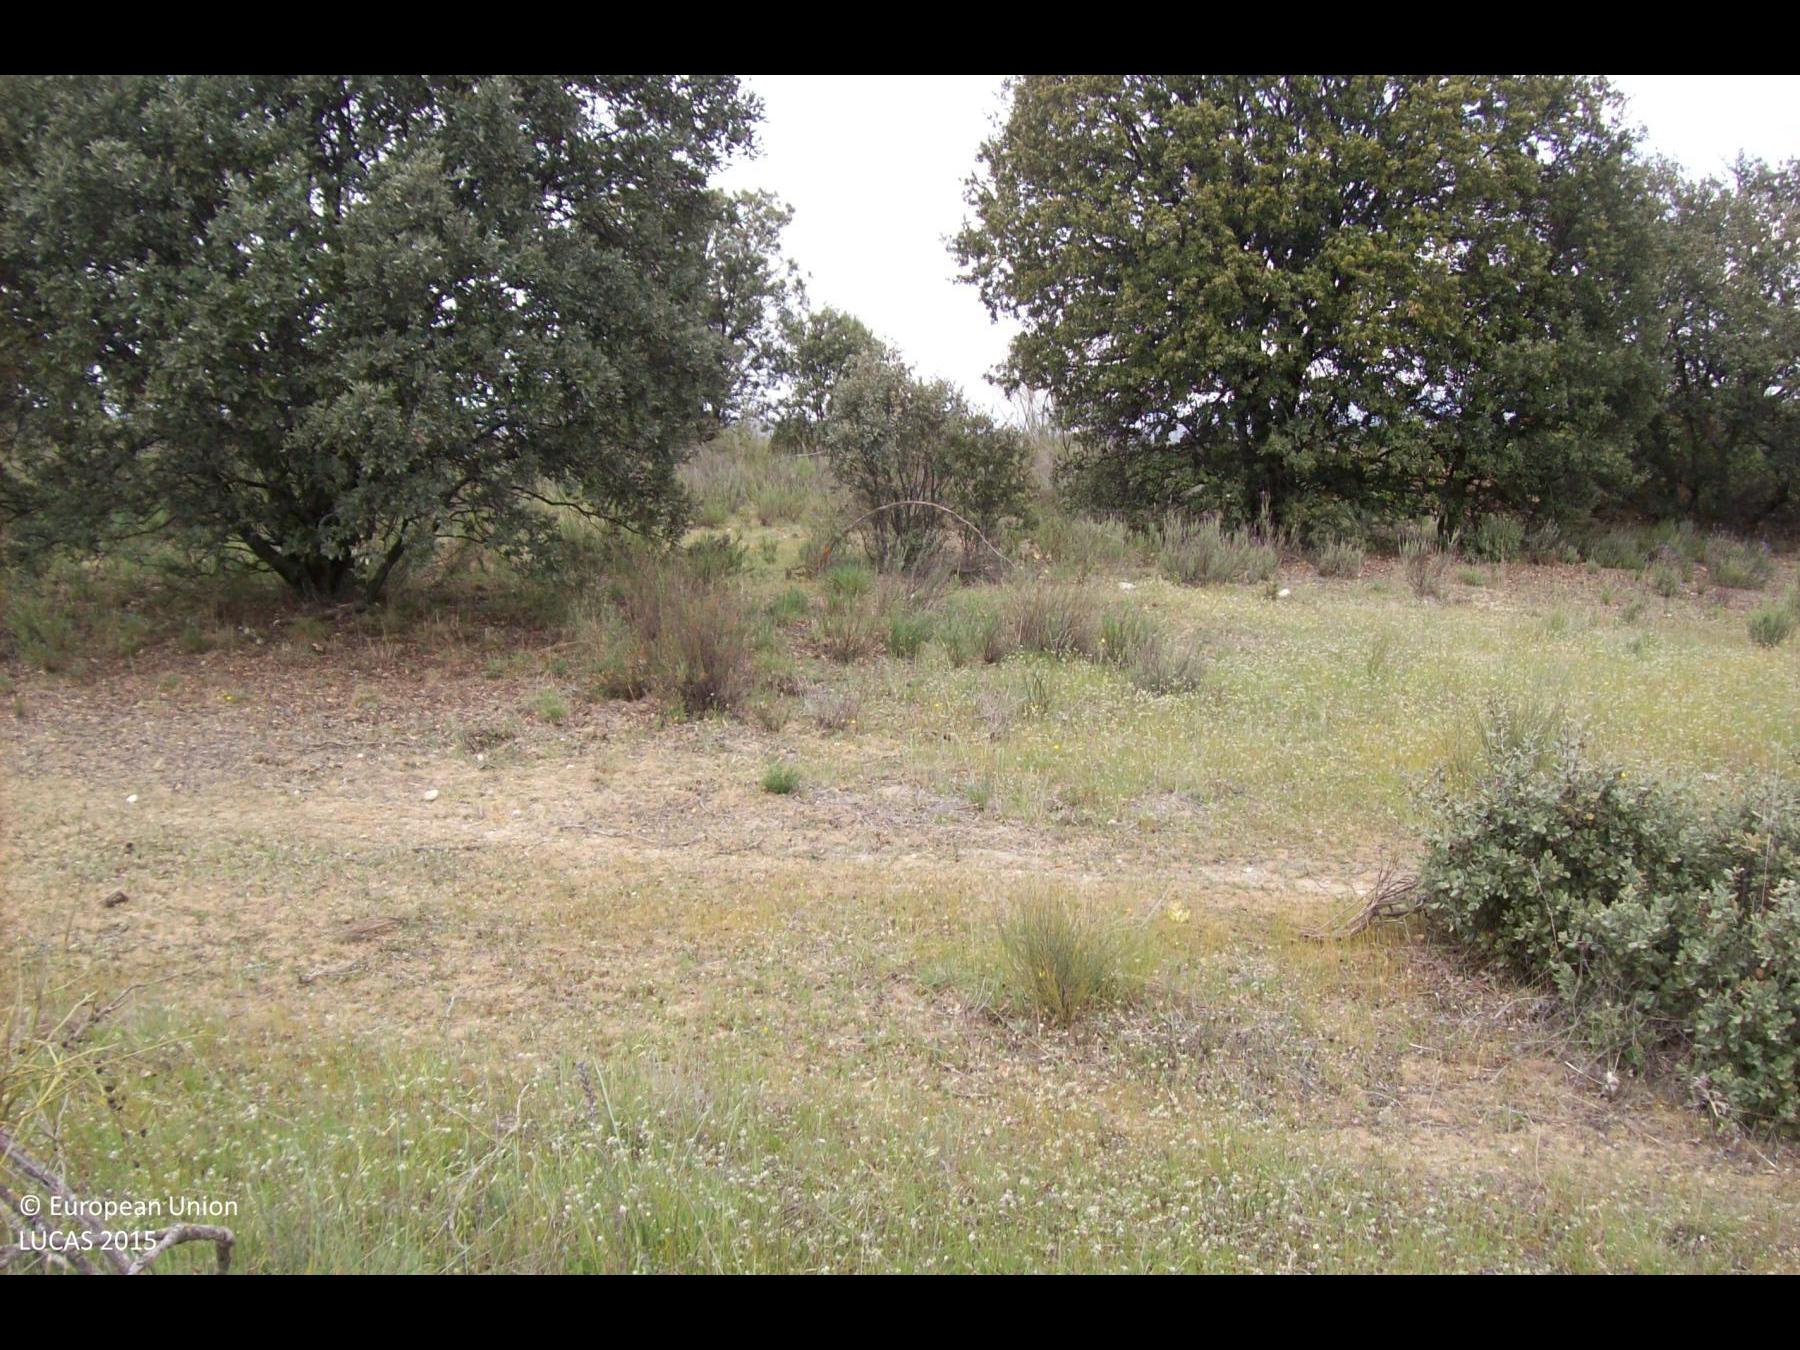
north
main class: Woodland
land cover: Broadleaved woodland
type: broadleaved evergreen forest
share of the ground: 25 - 50 %
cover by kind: herbaceous plants 65 %, broadleaved forest trees 25 %, shrubs 10 %
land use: Semi-natural and natural areas not in use
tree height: < 5 m
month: April
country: ES
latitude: 40.5106
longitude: -3.9564
